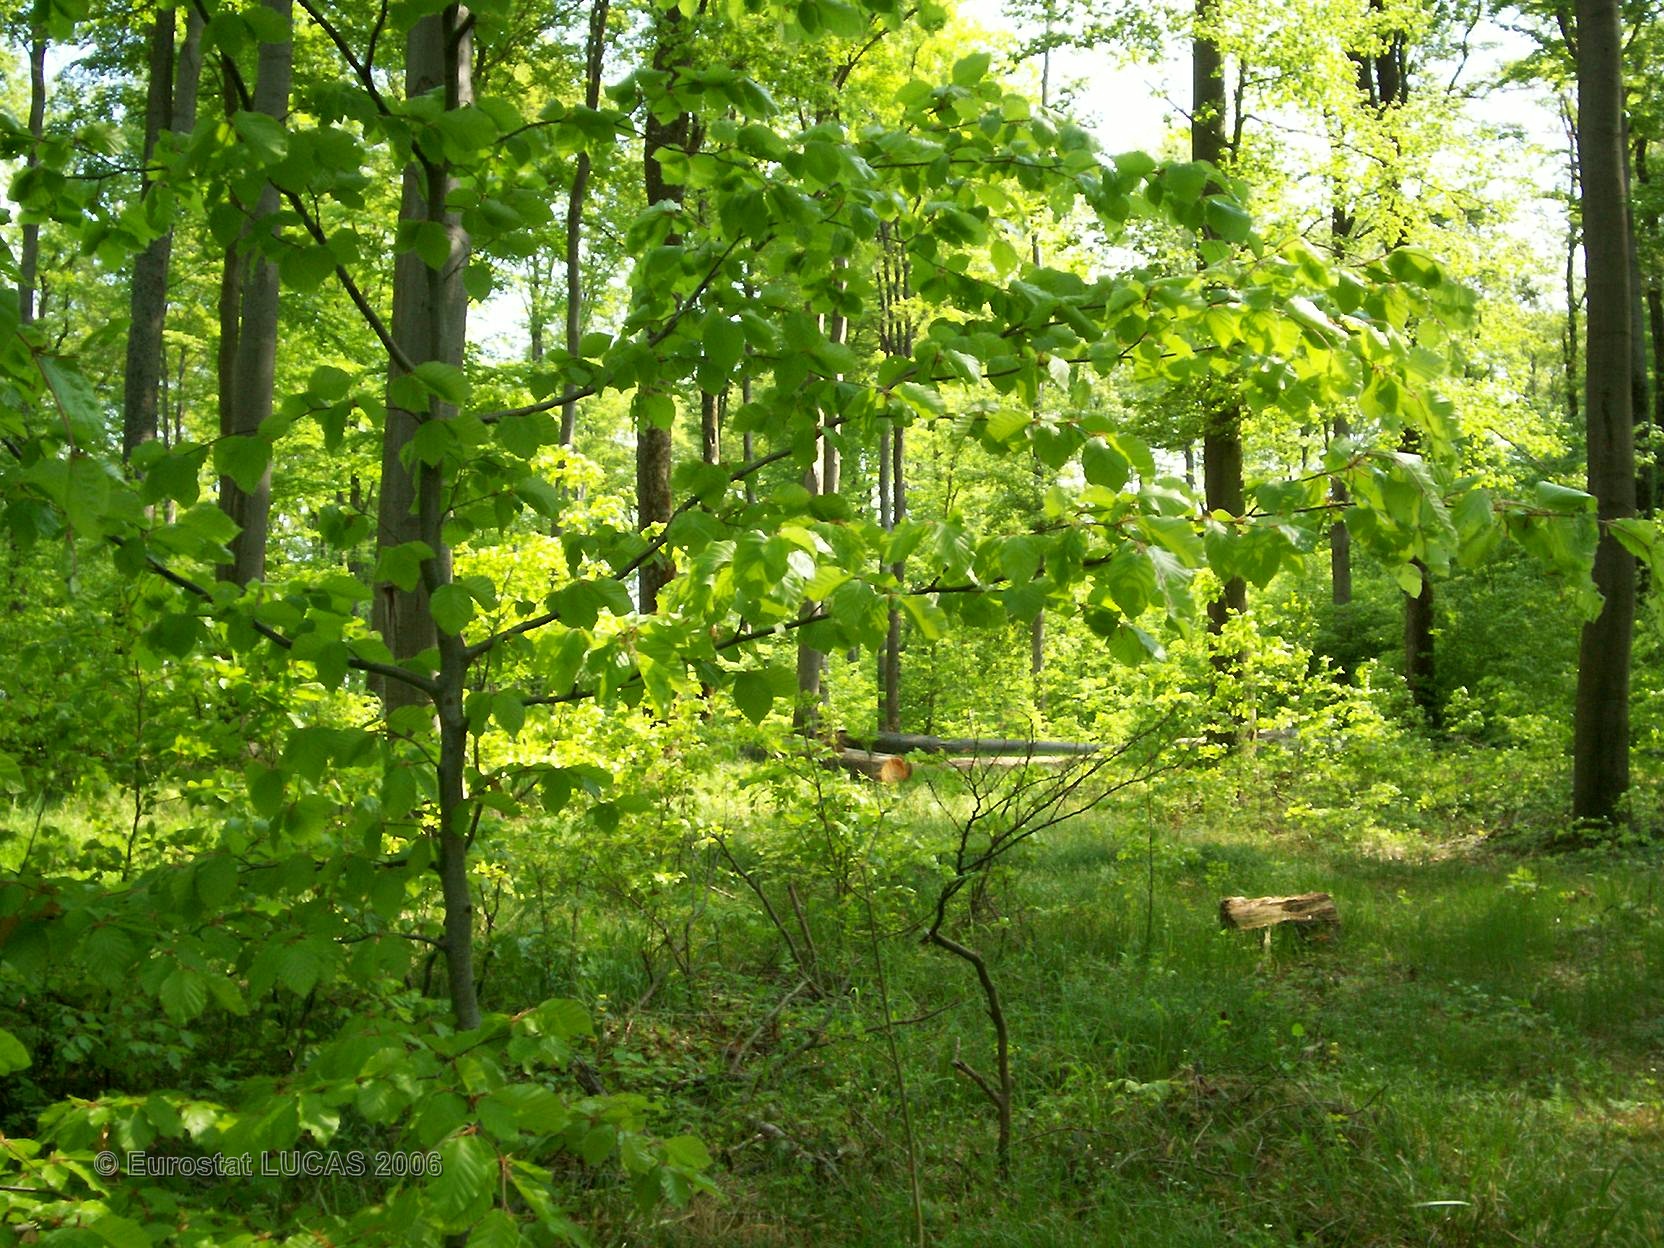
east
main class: Woodland
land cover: Broadleaved forest
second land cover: Grassland with sparse tree/shrub cover
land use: Forestry
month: May
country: FR
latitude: 47.7002
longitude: 7.1365
